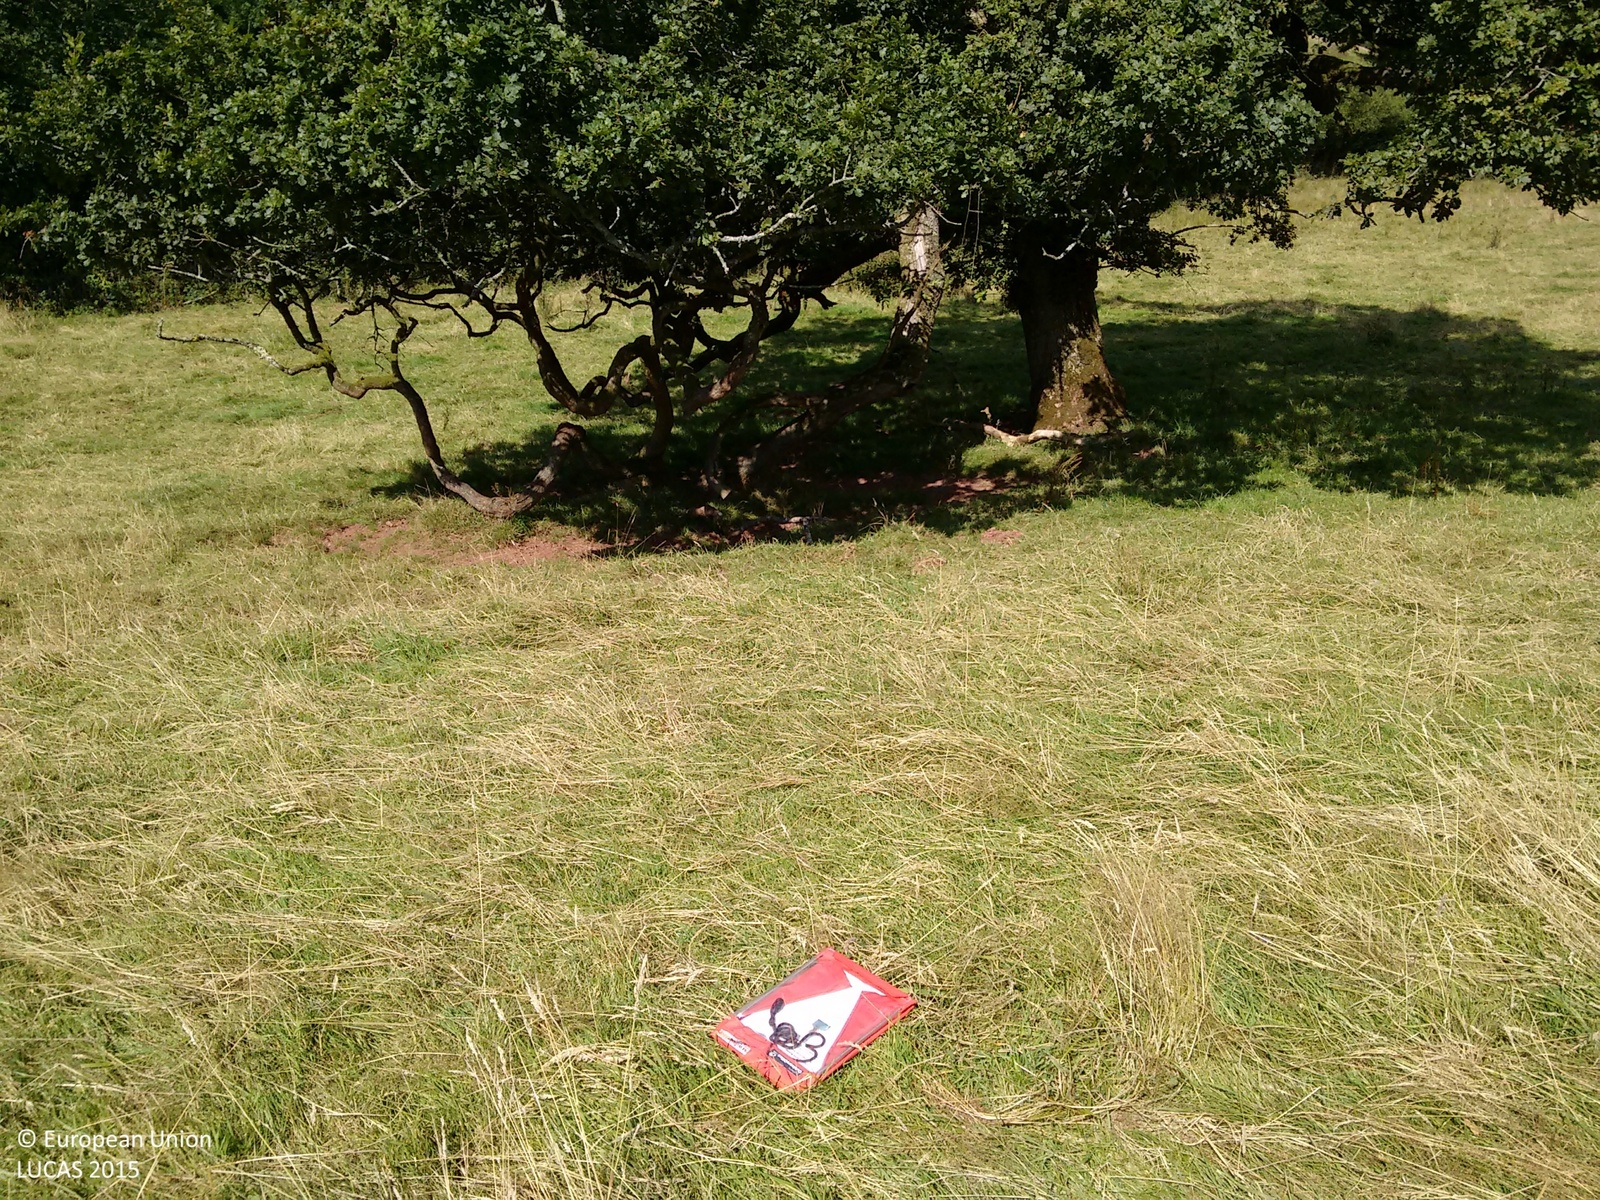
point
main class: Grassland
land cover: Grassland with sparse tree/shrub cover
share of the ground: > 75 %
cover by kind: herbaceous plants 95 %, broadleaved forest trees 5 %
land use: Agriculture (excluding fallow land and kitchen gardens)
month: August
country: GB
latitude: 51.7878
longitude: -4.3826
